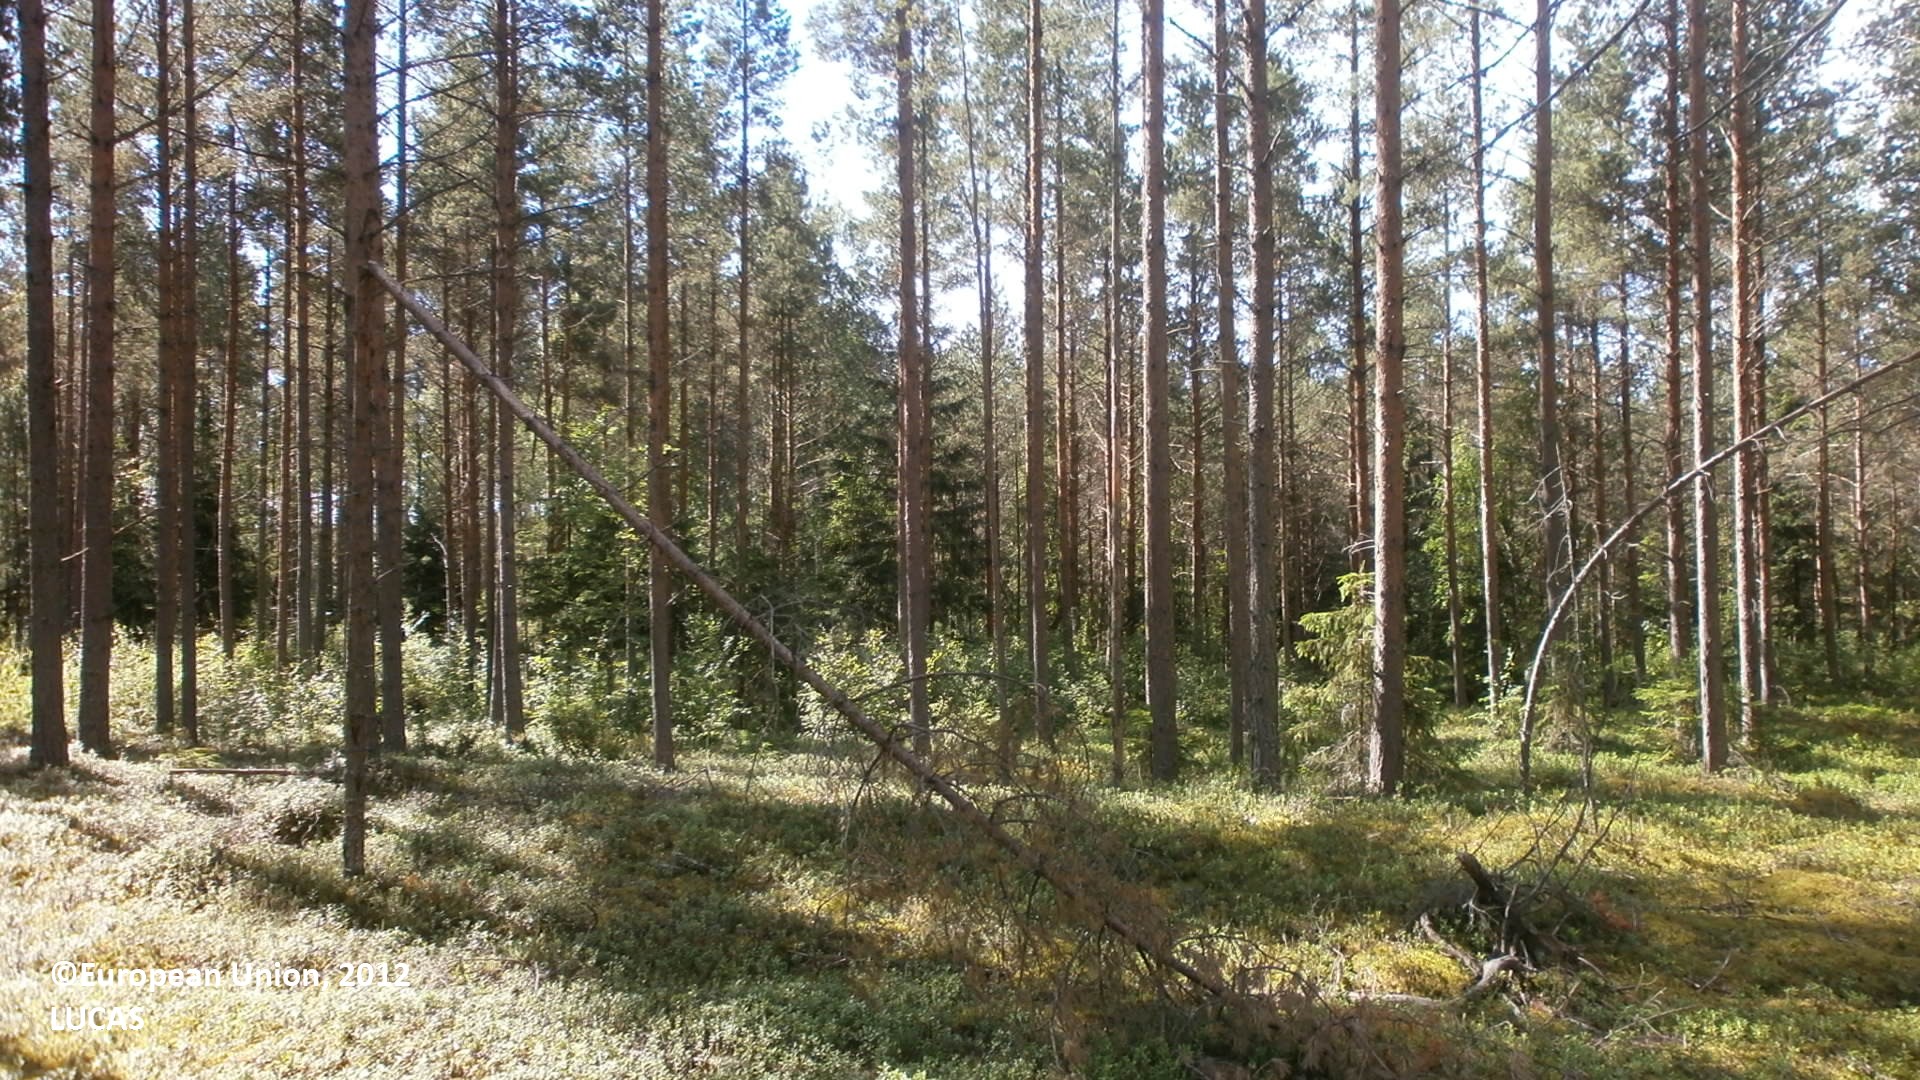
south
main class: Woodland
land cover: Pine dominated coniferous woodland
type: boreal forest
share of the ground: 50 - 75 %
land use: Forestry
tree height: > 5 m
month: July
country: FI
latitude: 64.3867
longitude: 24.1413
